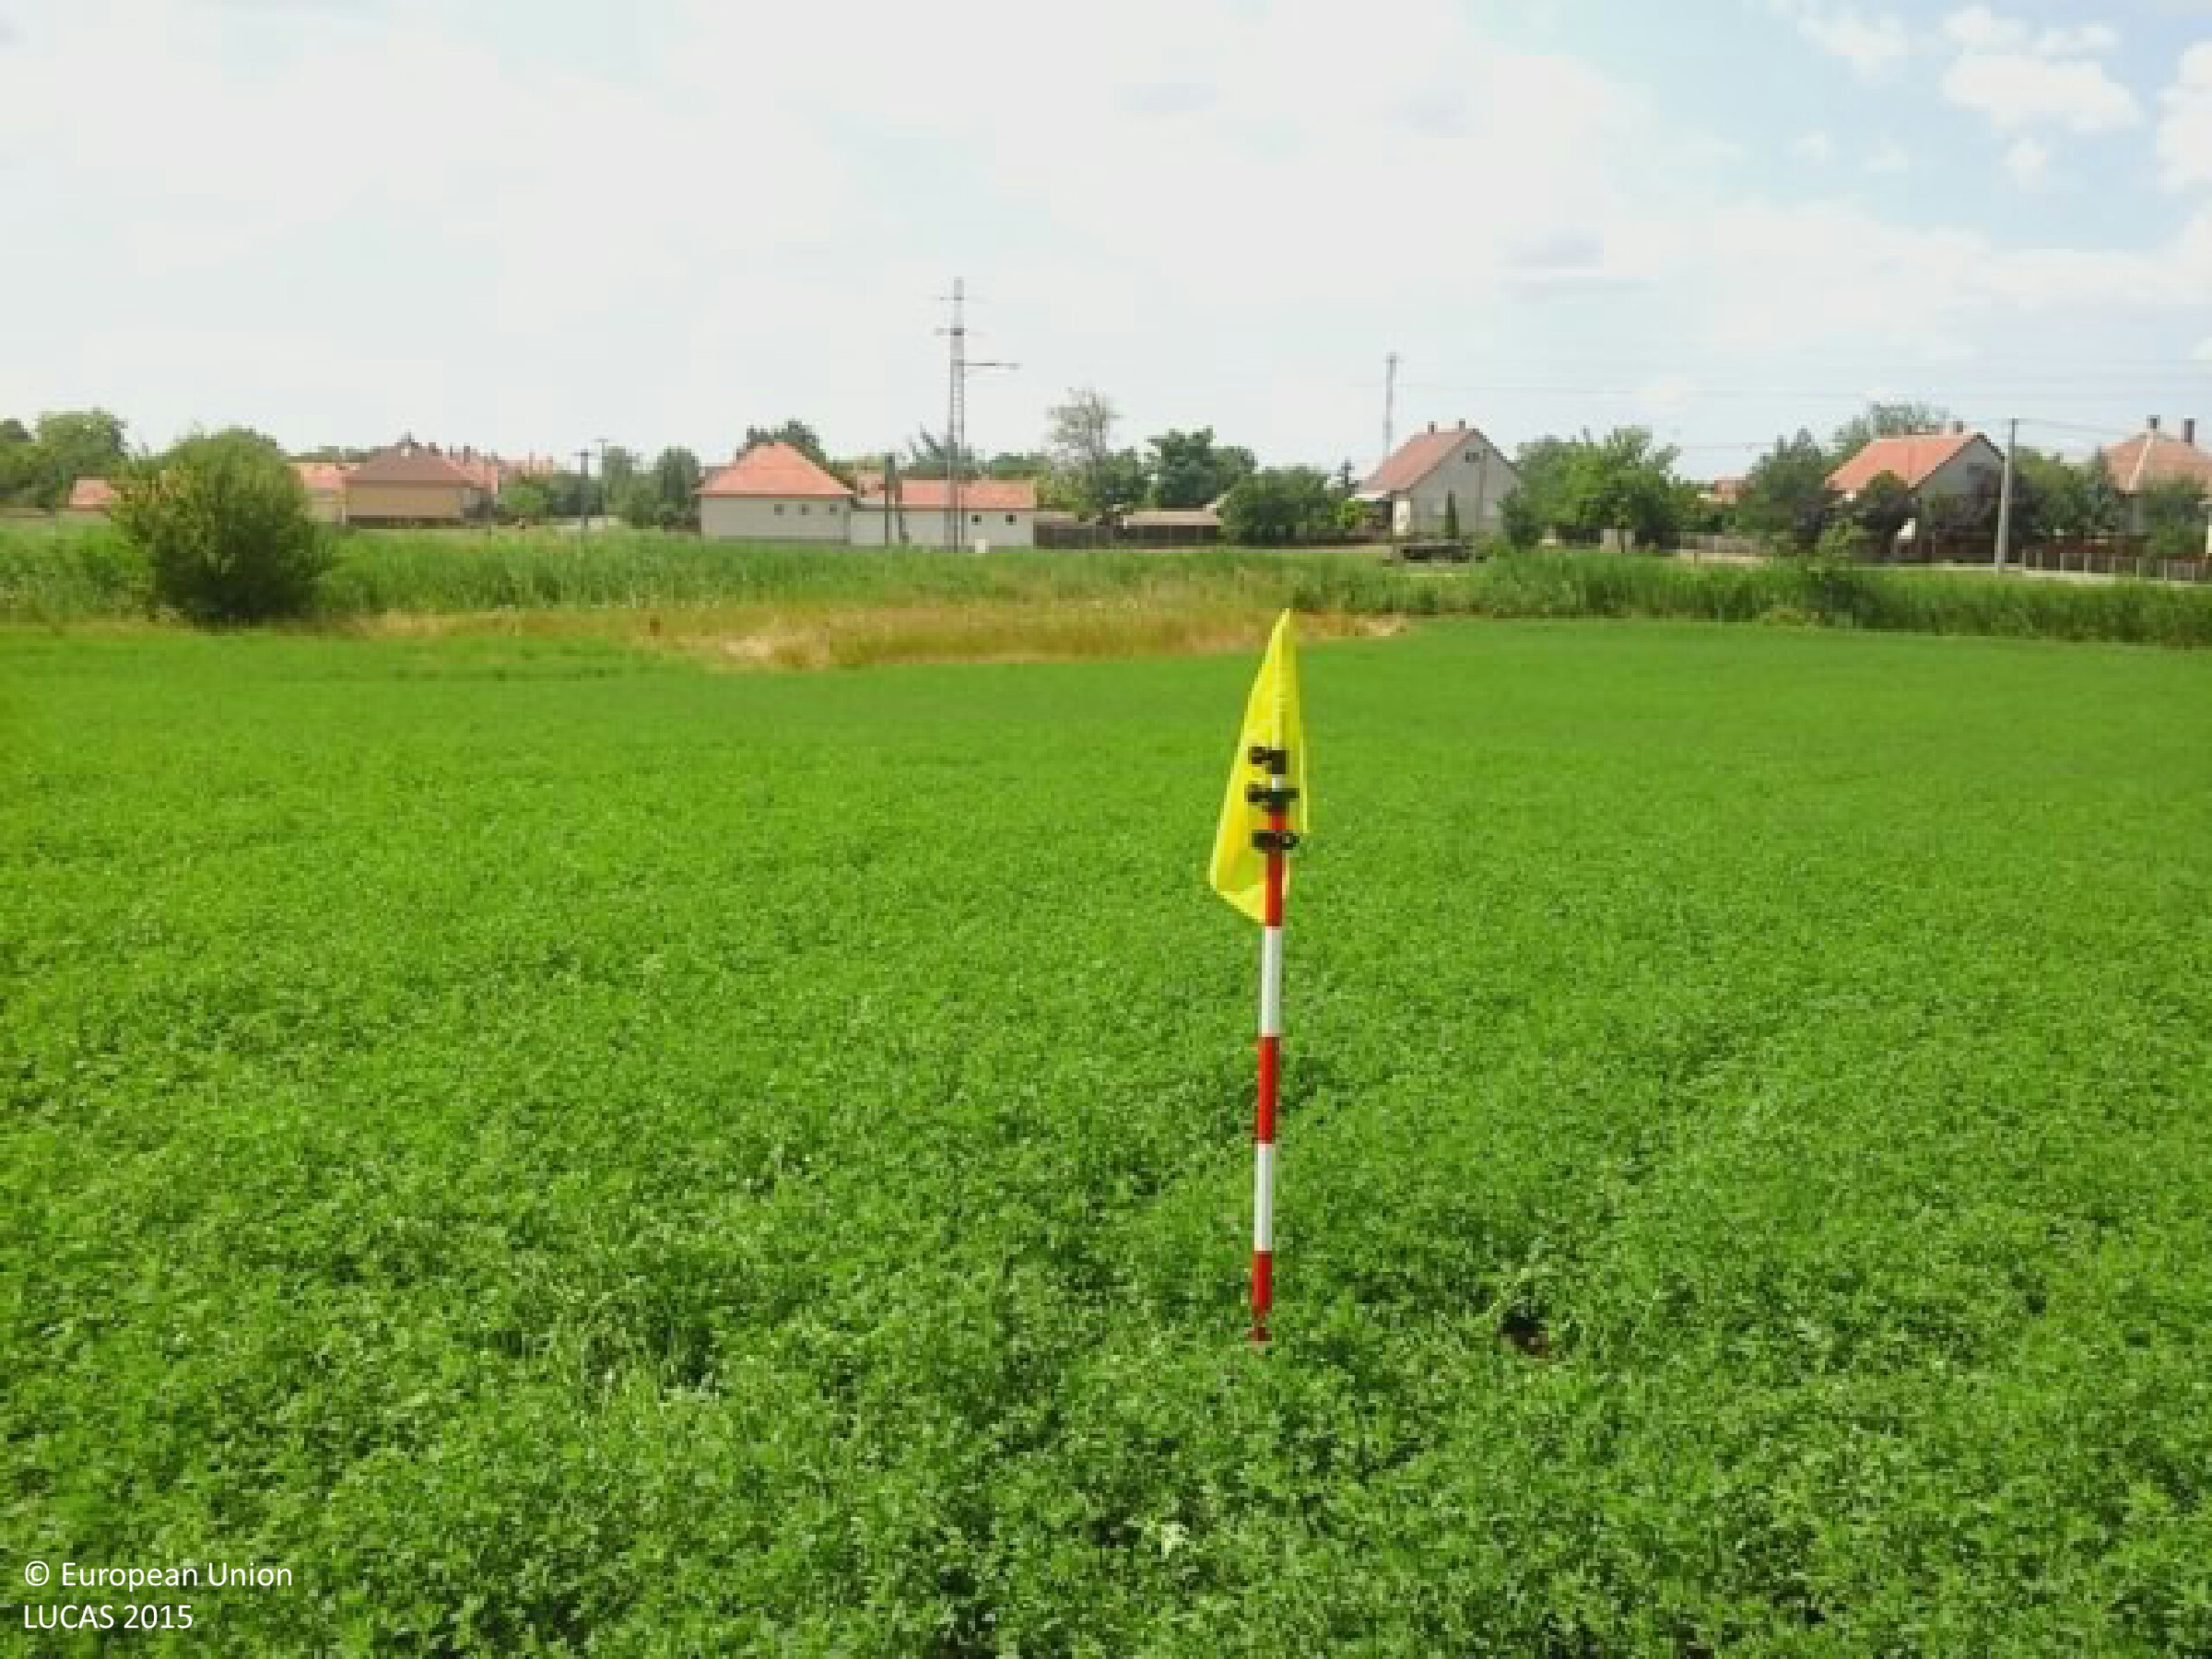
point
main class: Cropland
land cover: Lucerne
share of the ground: > 75 %
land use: Agriculture (excluding fallow land and kitchen gardens)
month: July
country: HU
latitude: 47.6157
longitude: 21.3636
